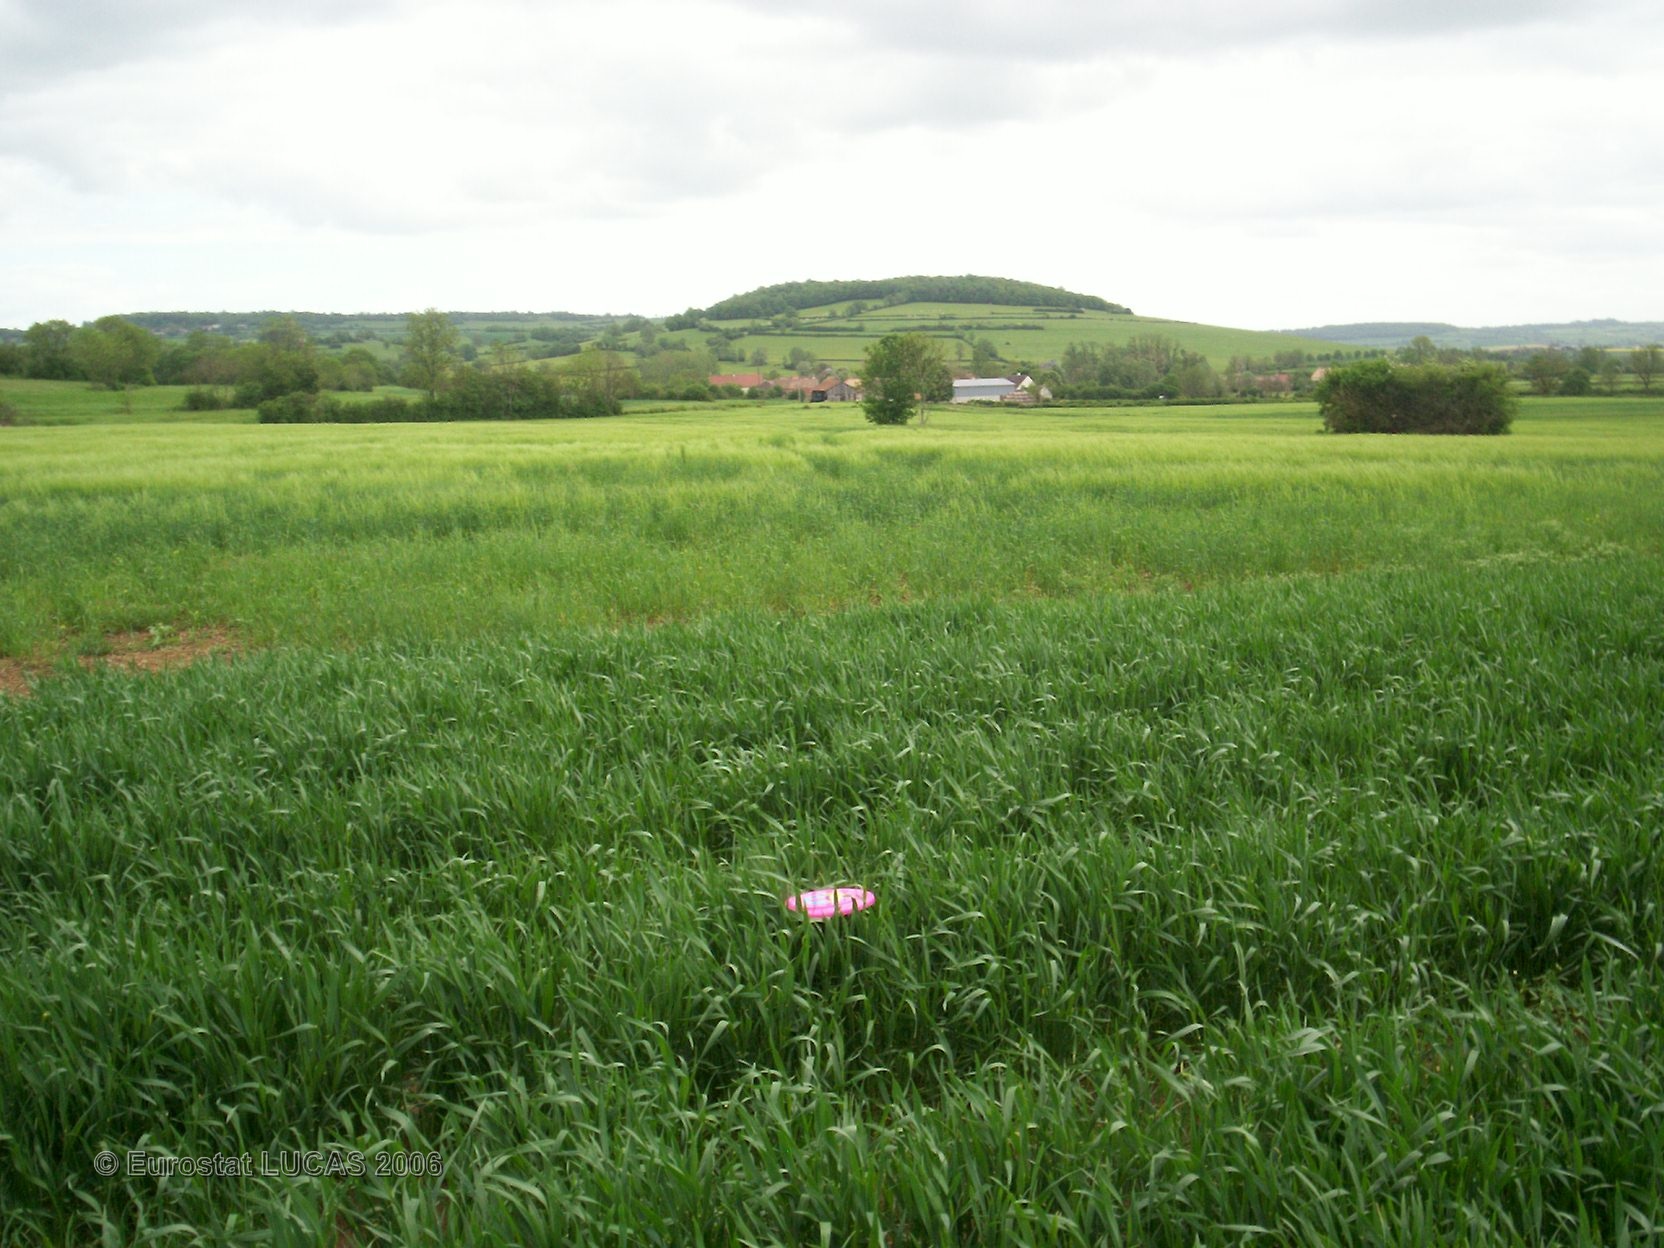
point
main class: Cropland
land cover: Common wheat
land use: Agriculture (excluding fallow land and kitchen gardens)
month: May
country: FR
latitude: 47.1535
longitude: 4.6058
